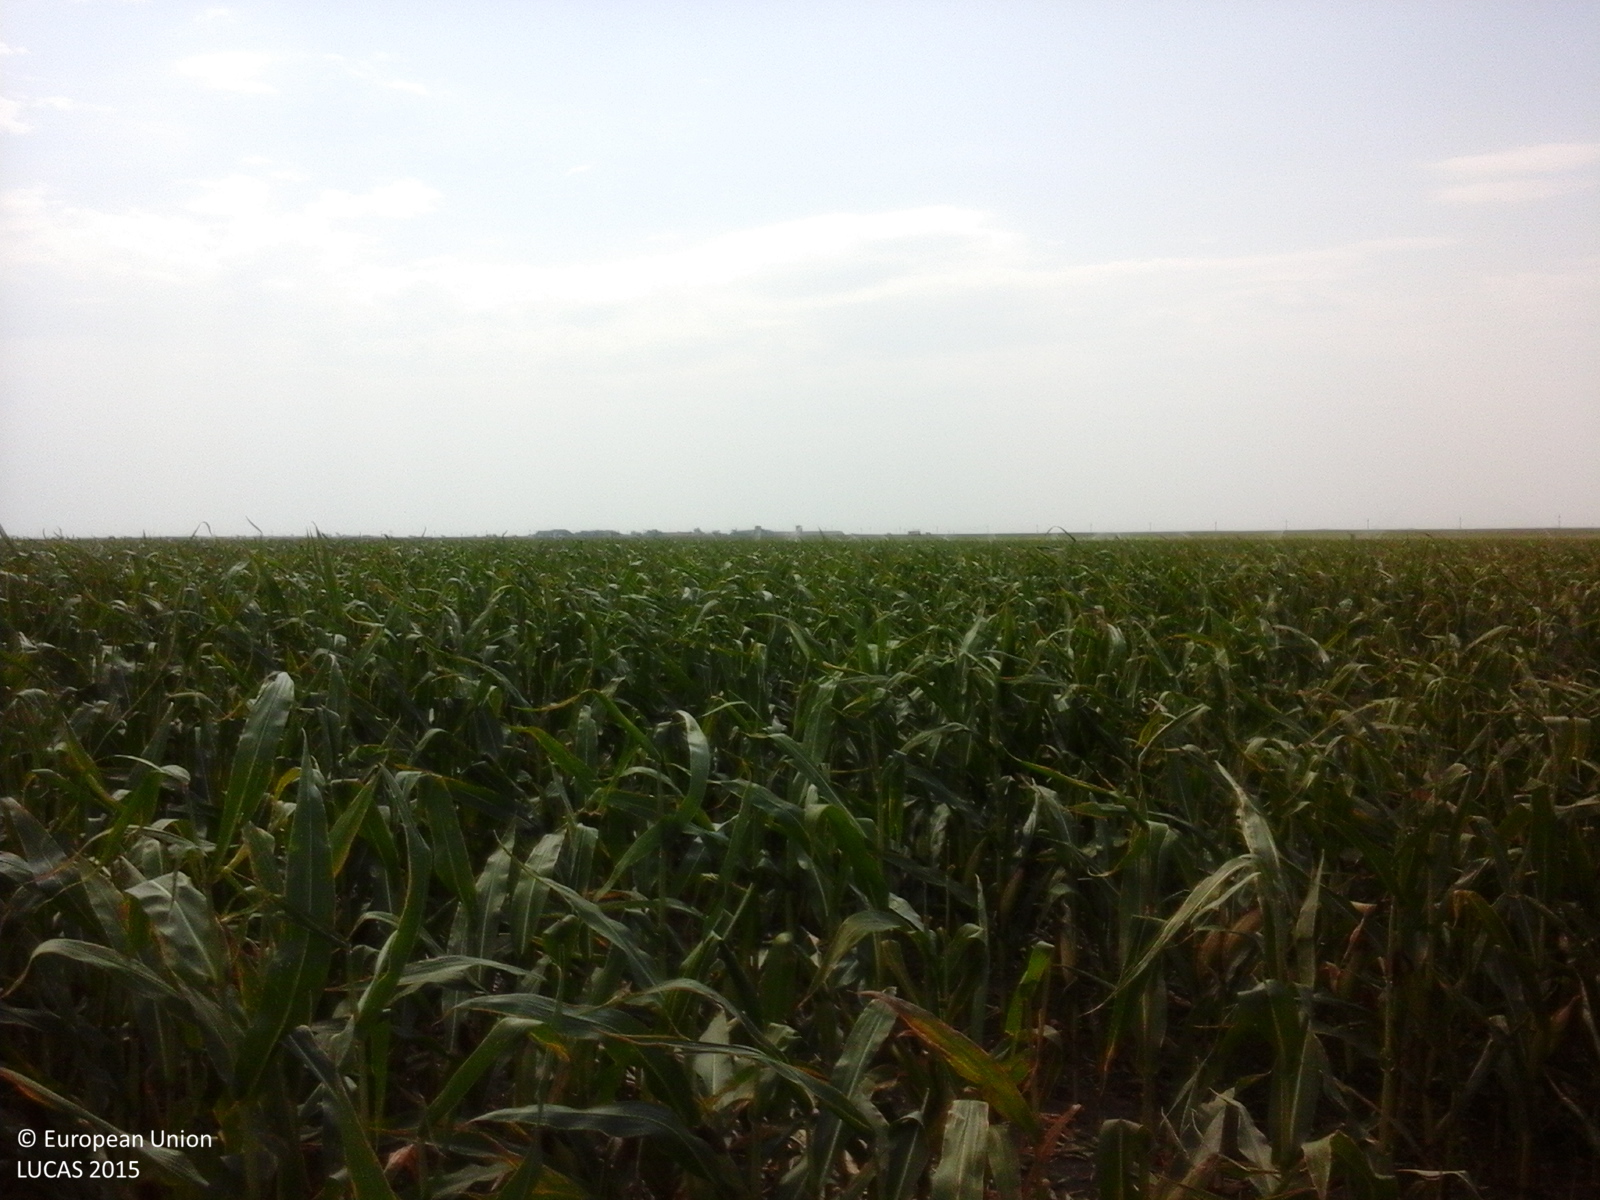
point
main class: Cropland
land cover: Maize
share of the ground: > 75 %
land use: Agriculture (excluding fallow land and kitchen gardens)
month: August
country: RO
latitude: 45.0985
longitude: 27.7048
